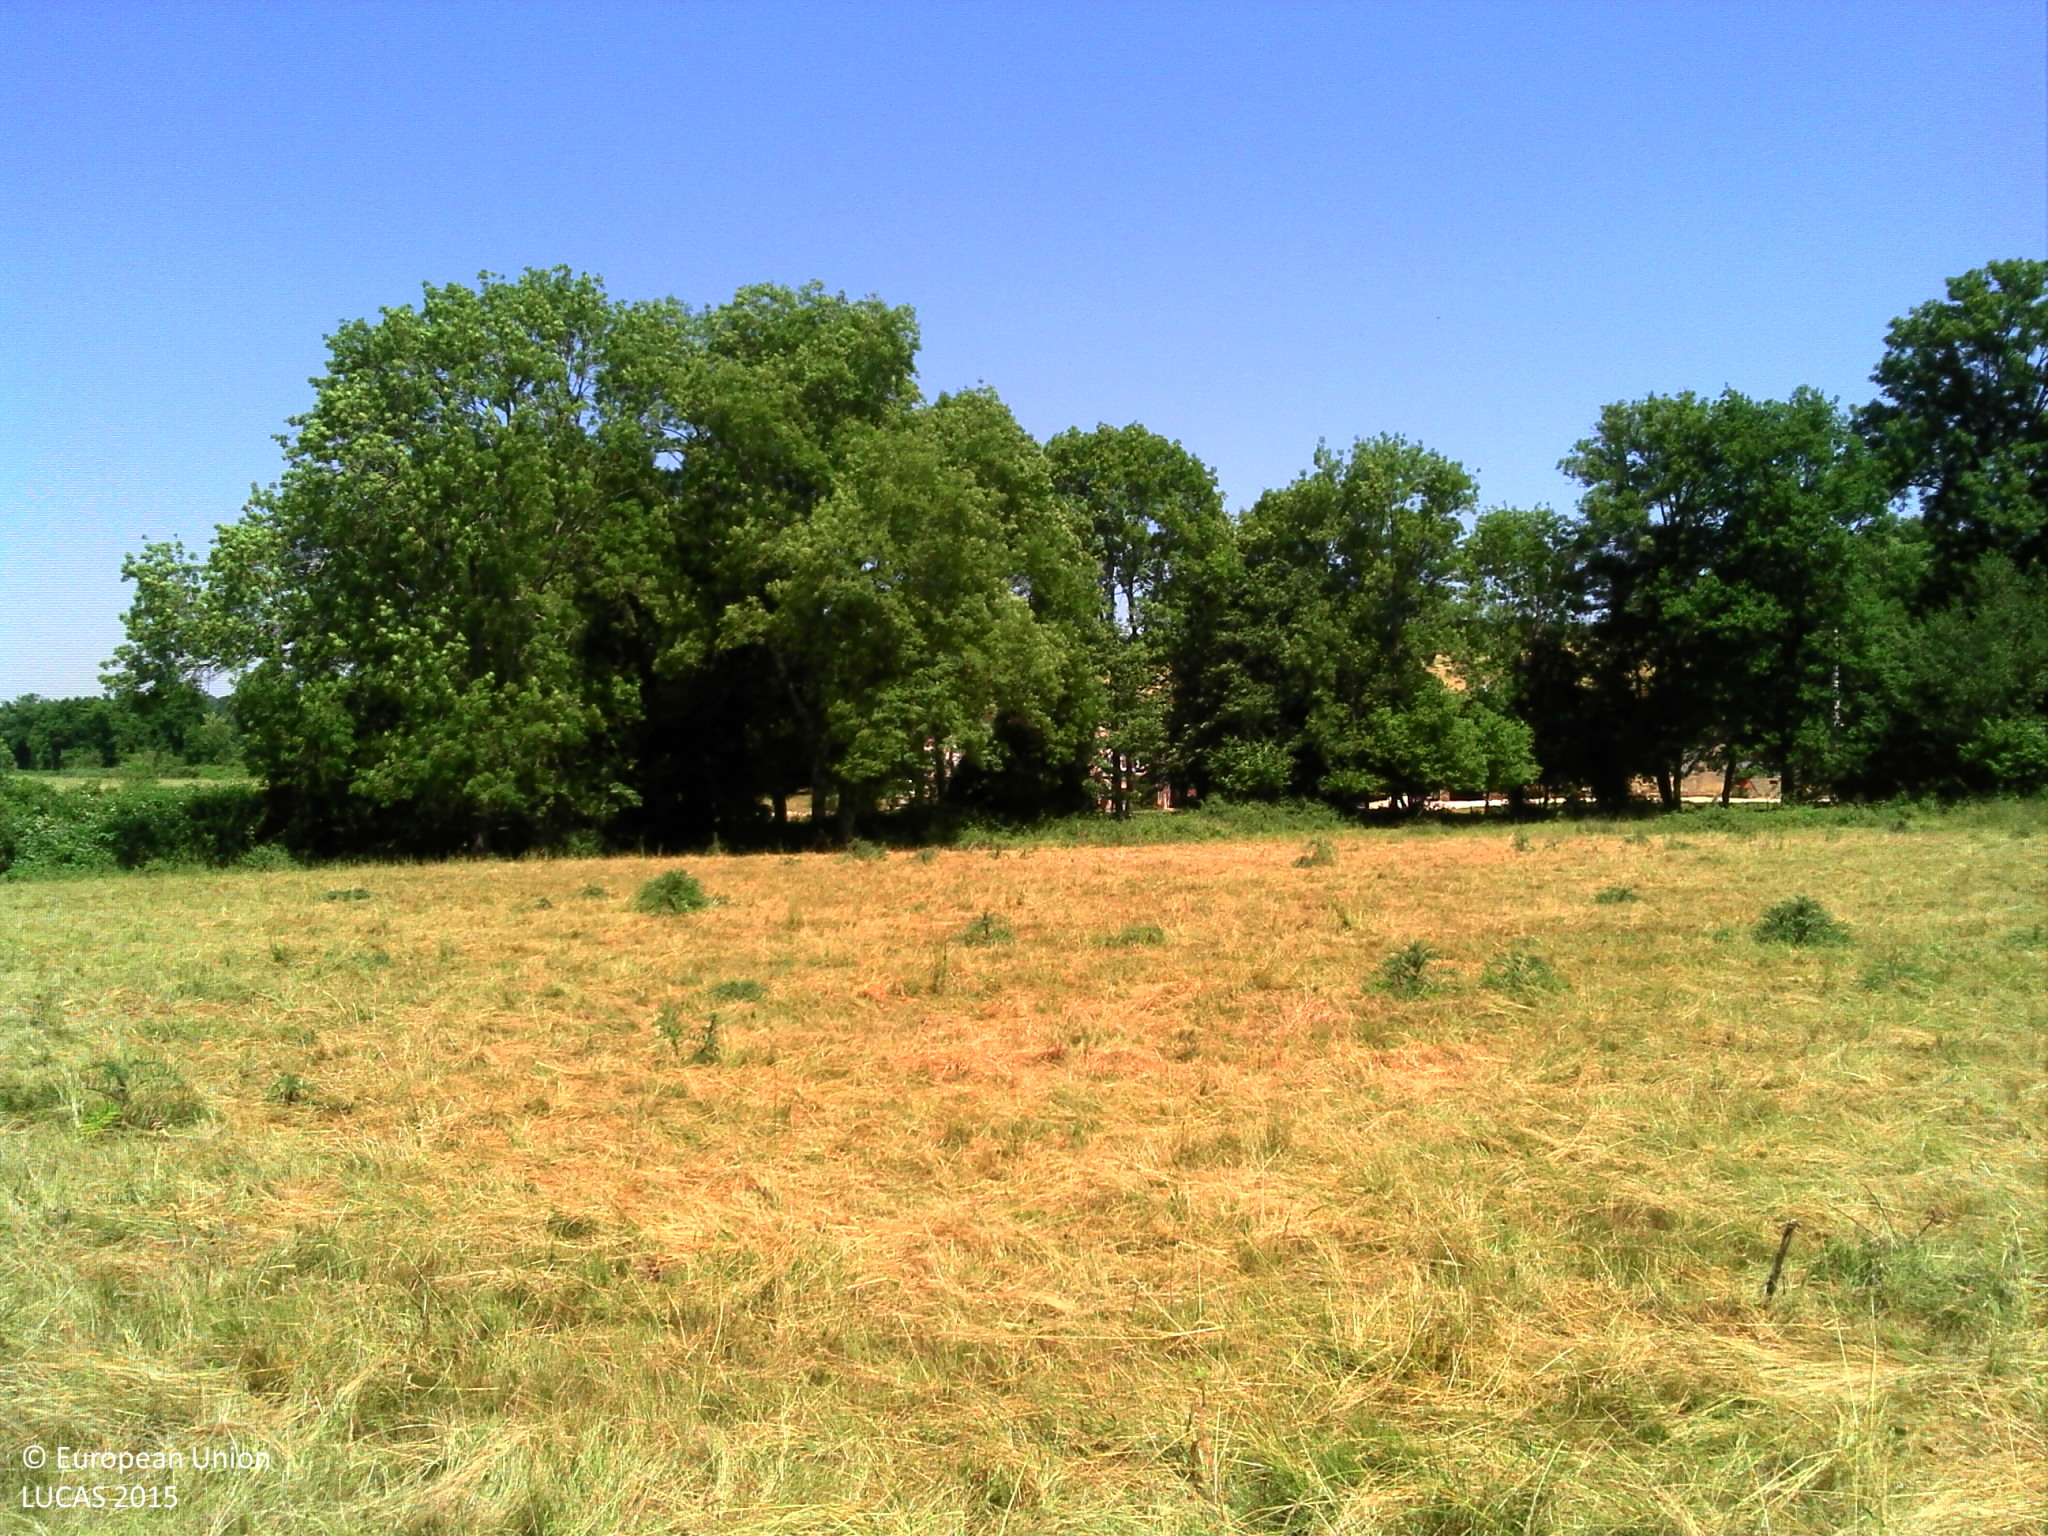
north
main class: Grassland
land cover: Grassland without tree/shrub cover
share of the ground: > 75 %
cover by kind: herbaceous plants 100 %
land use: Agriculture (excluding fallow land and kitchen gardens)
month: June
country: FR
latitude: 46.1070
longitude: 0.6837
